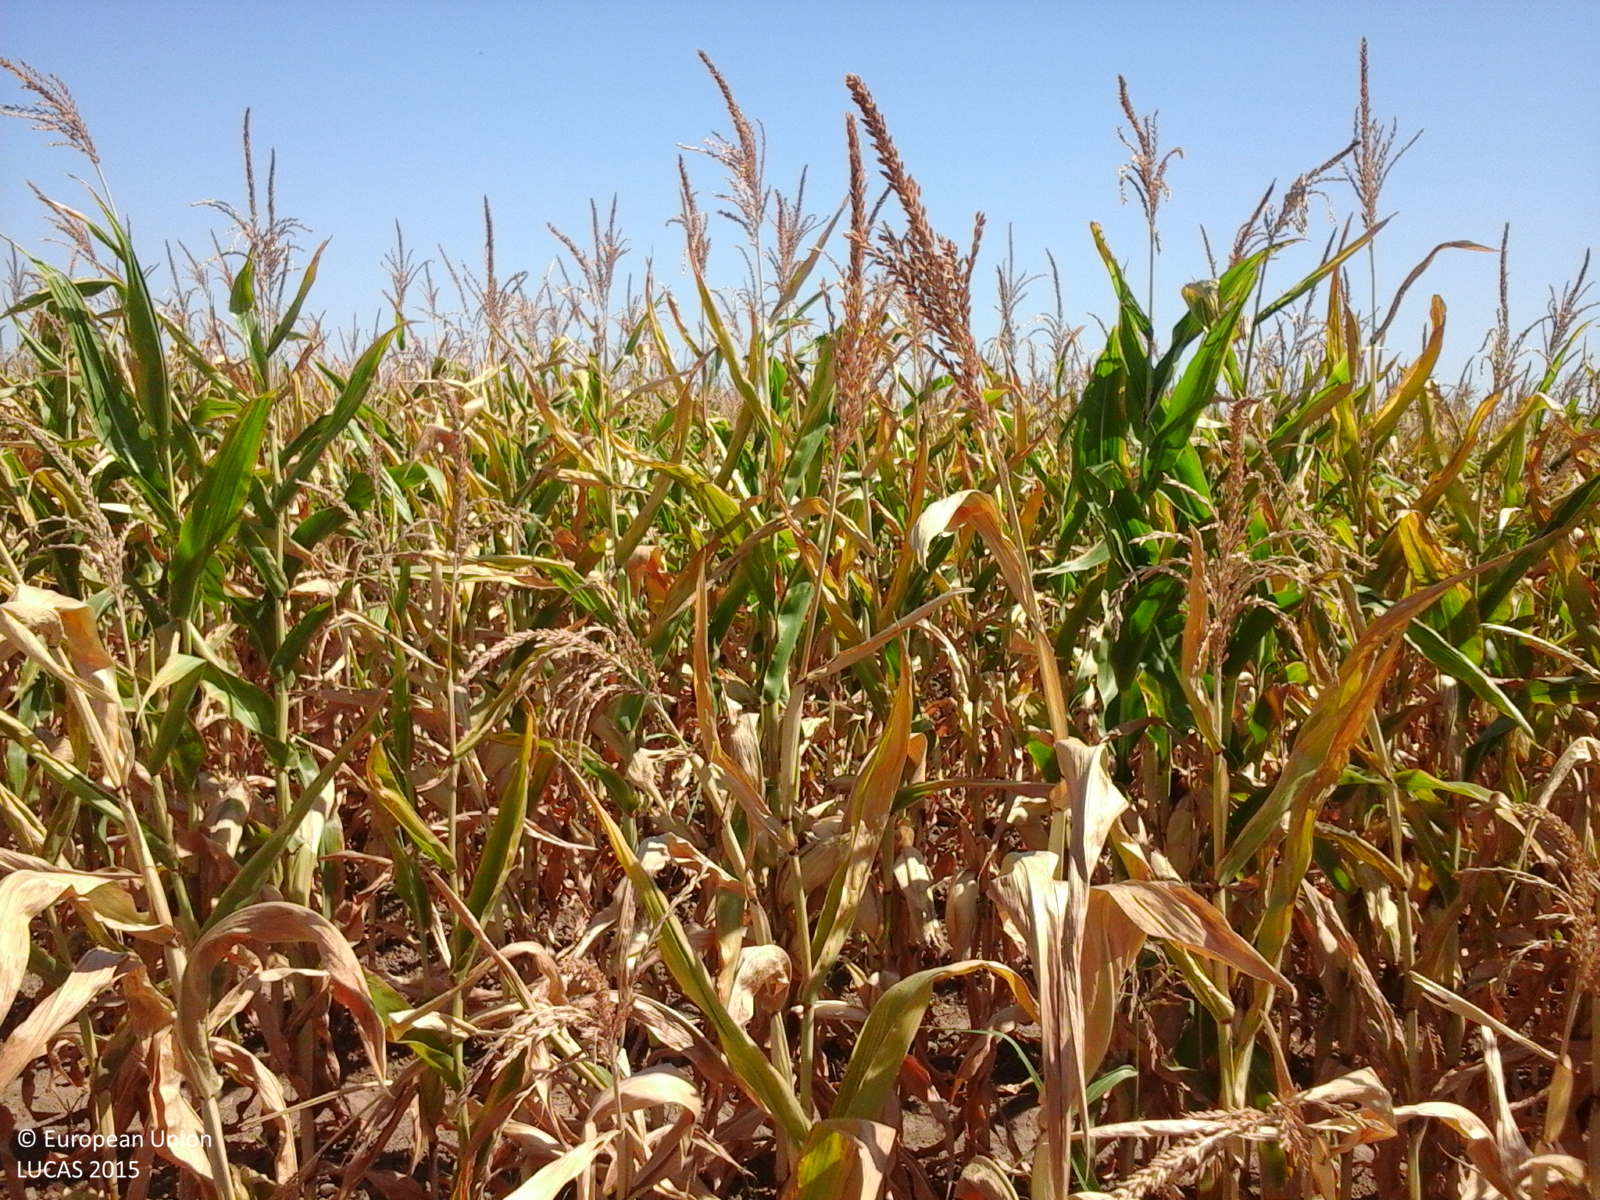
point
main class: Cropland
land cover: Maize
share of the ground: > 75 %
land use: Agriculture (excluding fallow land and kitchen gardens)
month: August
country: RO
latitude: 44.6681
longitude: 28.0599
